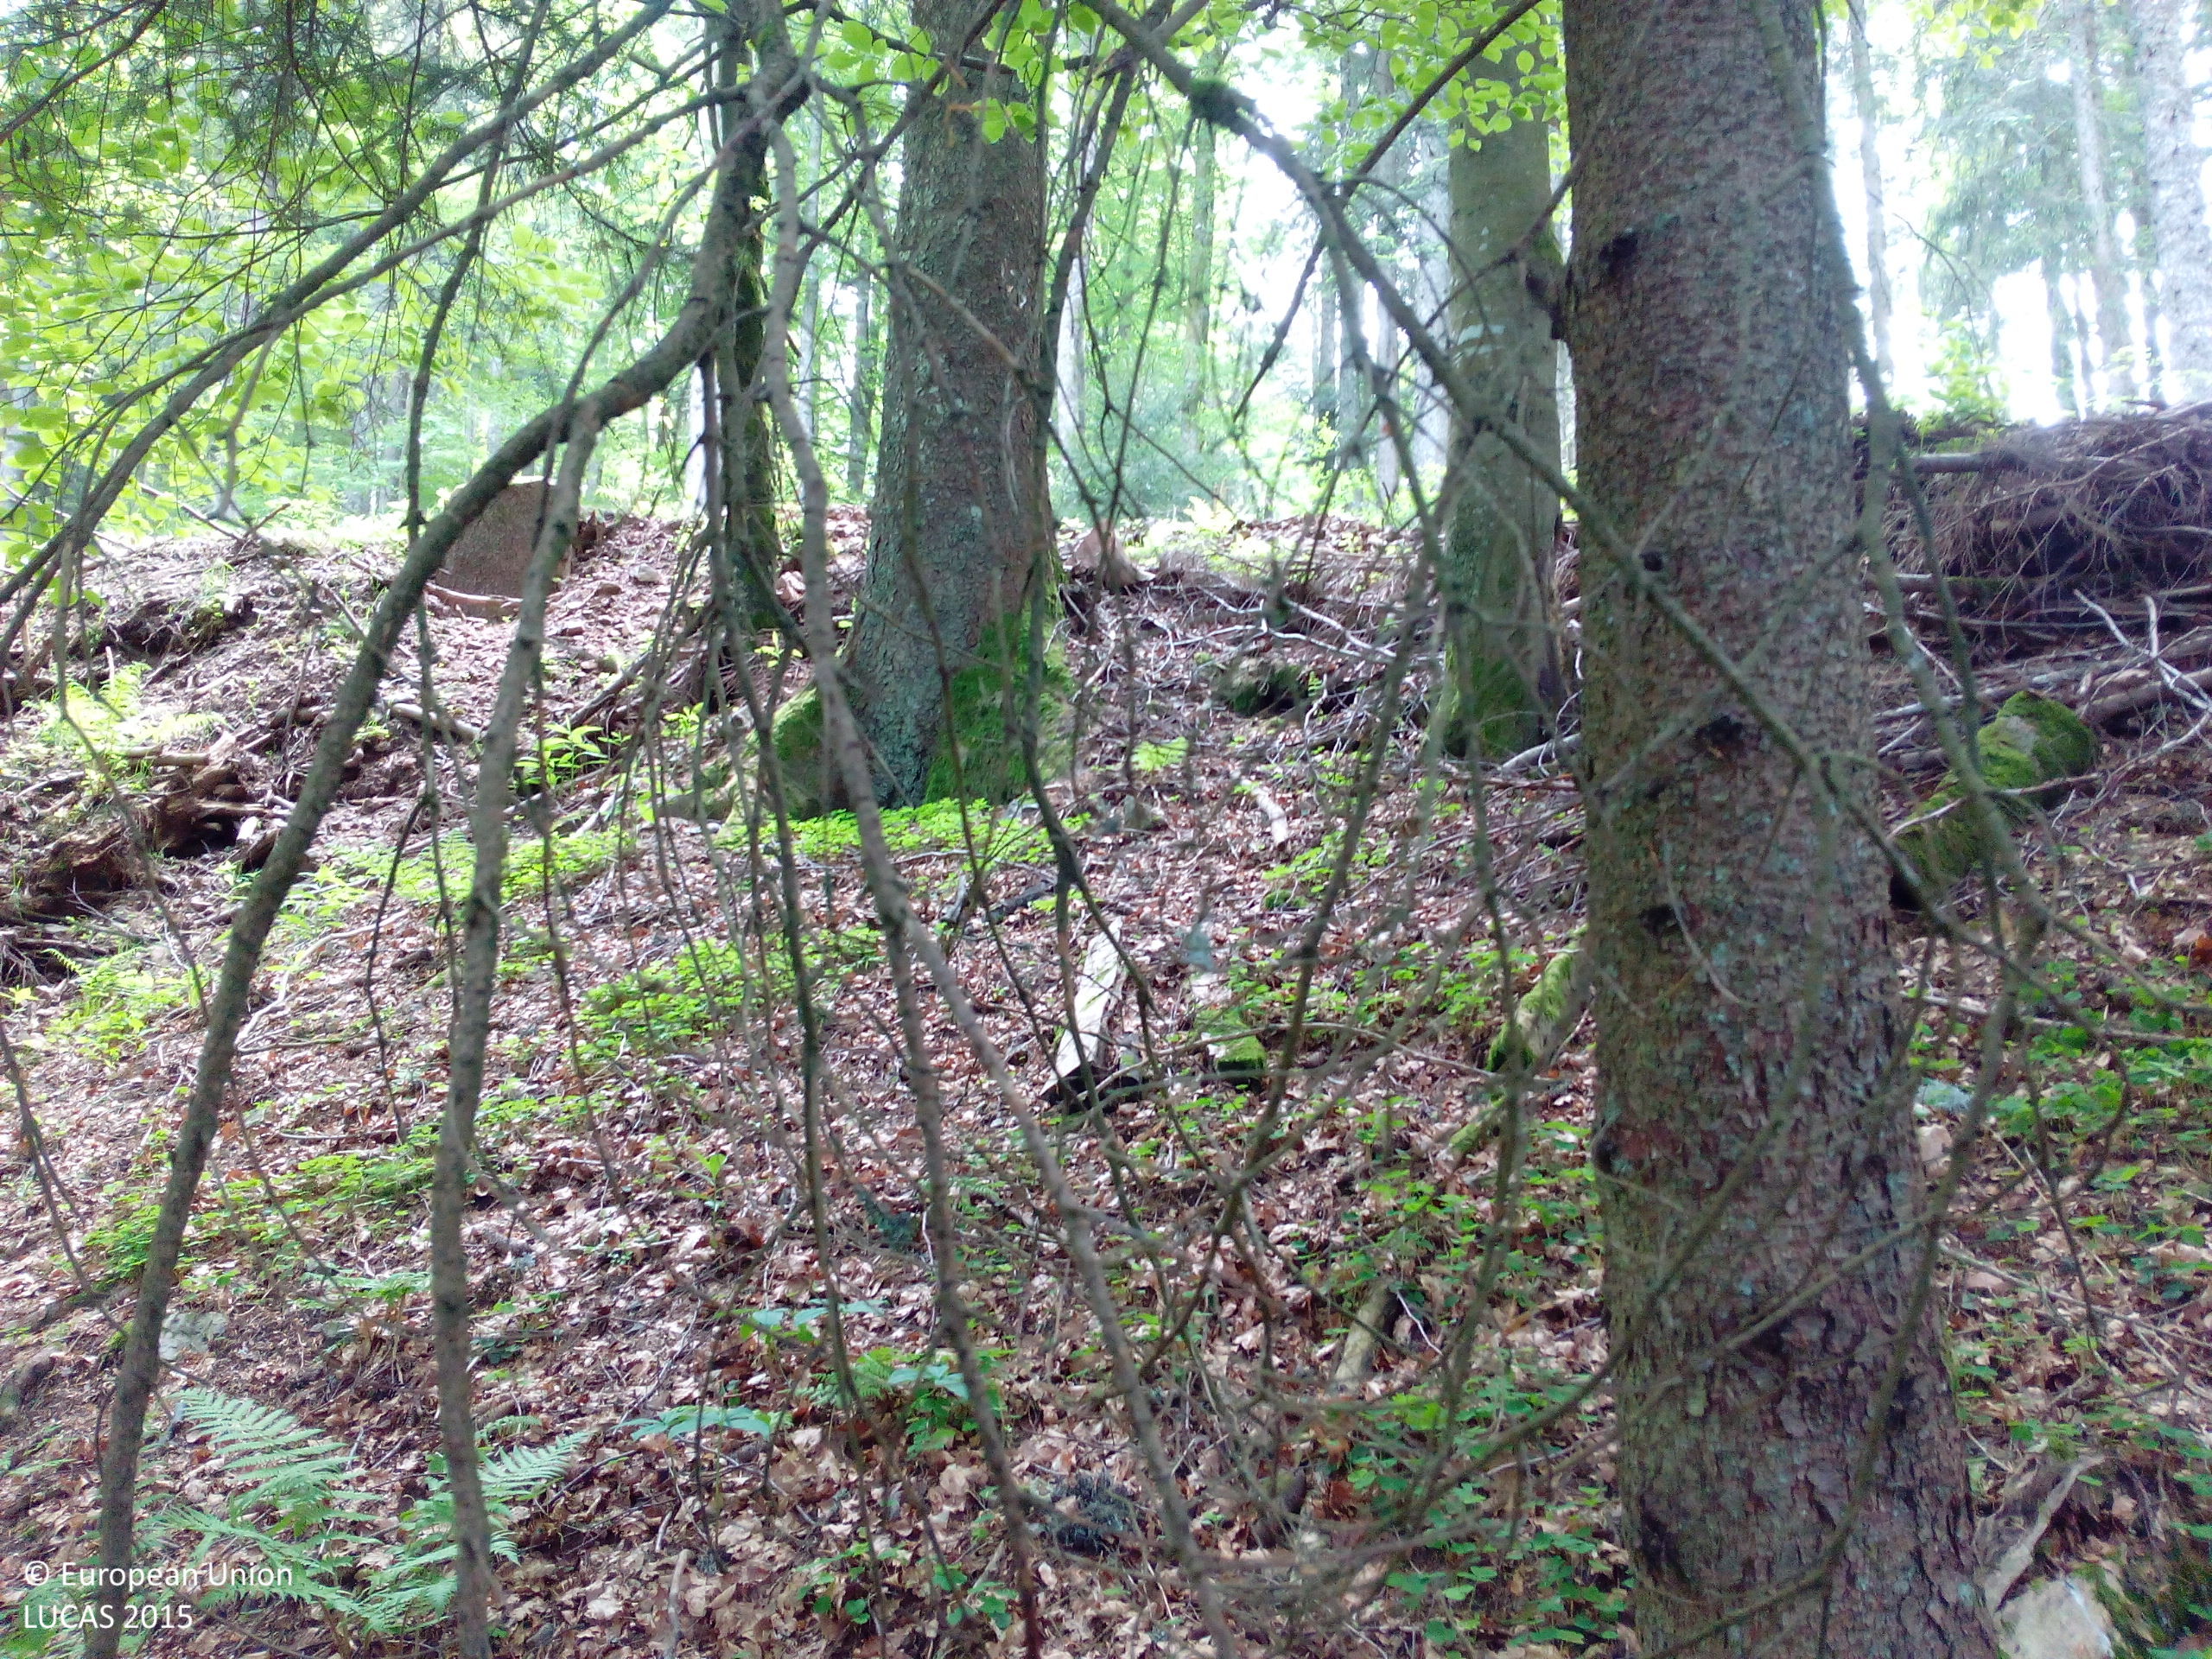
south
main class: Woodland
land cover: Other mixed woodland
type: hemiboreal forest and nemoral coniferous forest and mixed broadleaved-coniferous forest
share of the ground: > 75 %
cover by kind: coniferous forest trees 75 %, broadleaved forest trees 25 %
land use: Forestry
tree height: > 5 m
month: May
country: DE
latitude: 48.0107
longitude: 8.1913
